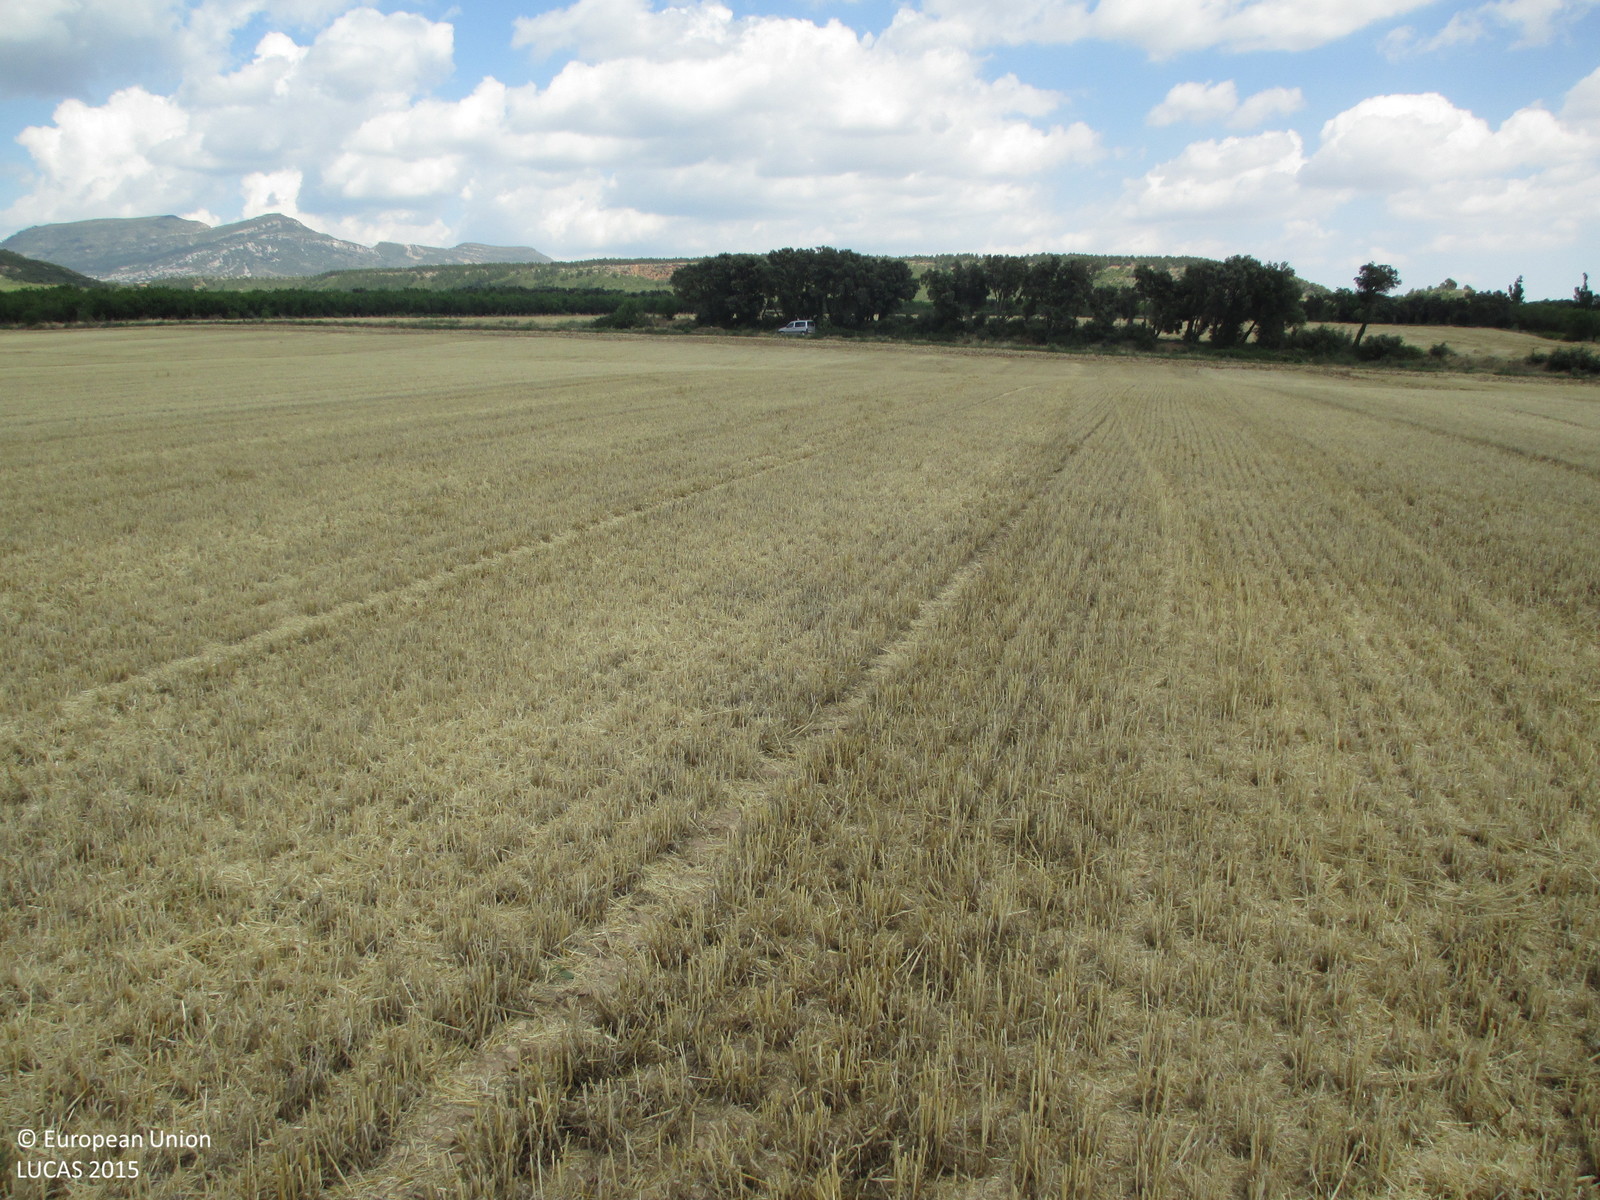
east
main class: Cropland
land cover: Barley
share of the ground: < 10 %
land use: Agriculture (excluding fallow land and kitchen gardens)
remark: Harvested field
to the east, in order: Barley; Grass margins; Tracks; Shruby margins; Lines of trees; Barley
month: June
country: ES
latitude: 42.2540
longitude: -0.4846
